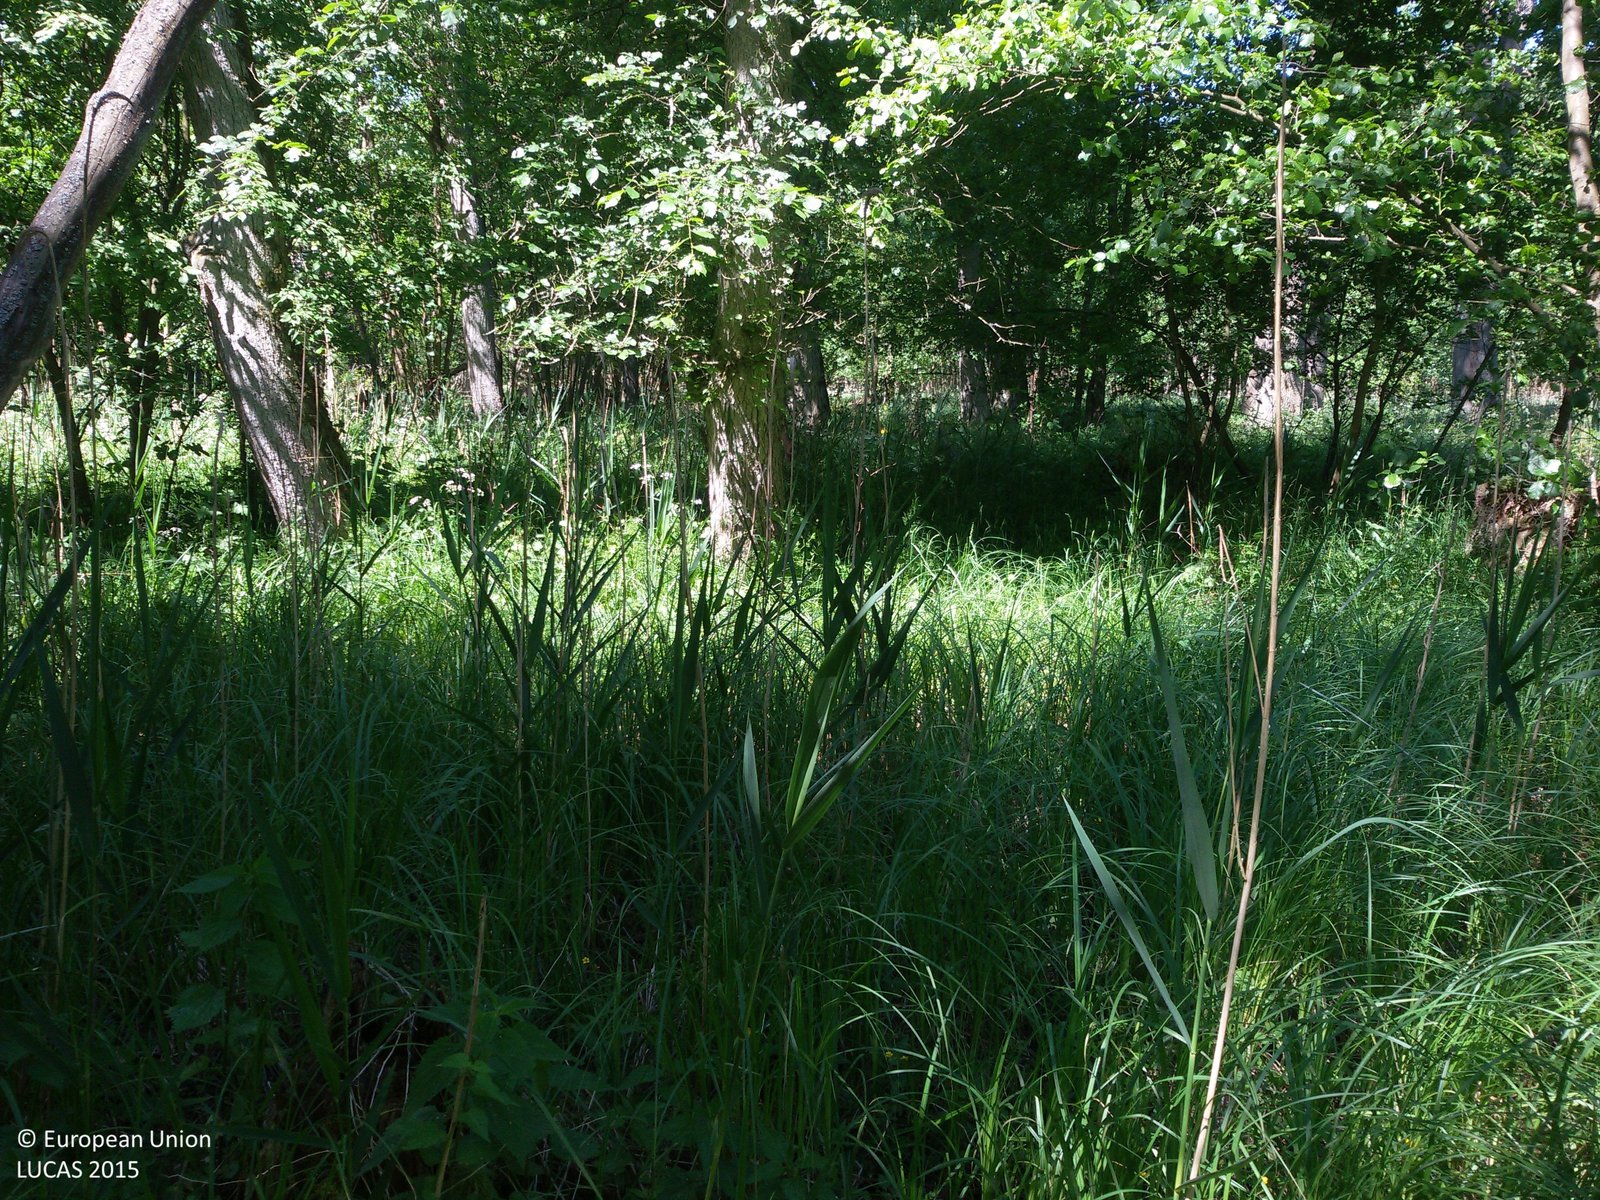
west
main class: Woodland
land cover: Broadleaved woodland
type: beech forest
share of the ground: 50 - 75 %
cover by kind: broadleaved forest trees 60 %, shrubs 20 %, herbaceous plants 20 %
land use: Forestry
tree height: > 5 m
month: June
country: PL
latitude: 53.2852
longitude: 17.0745
